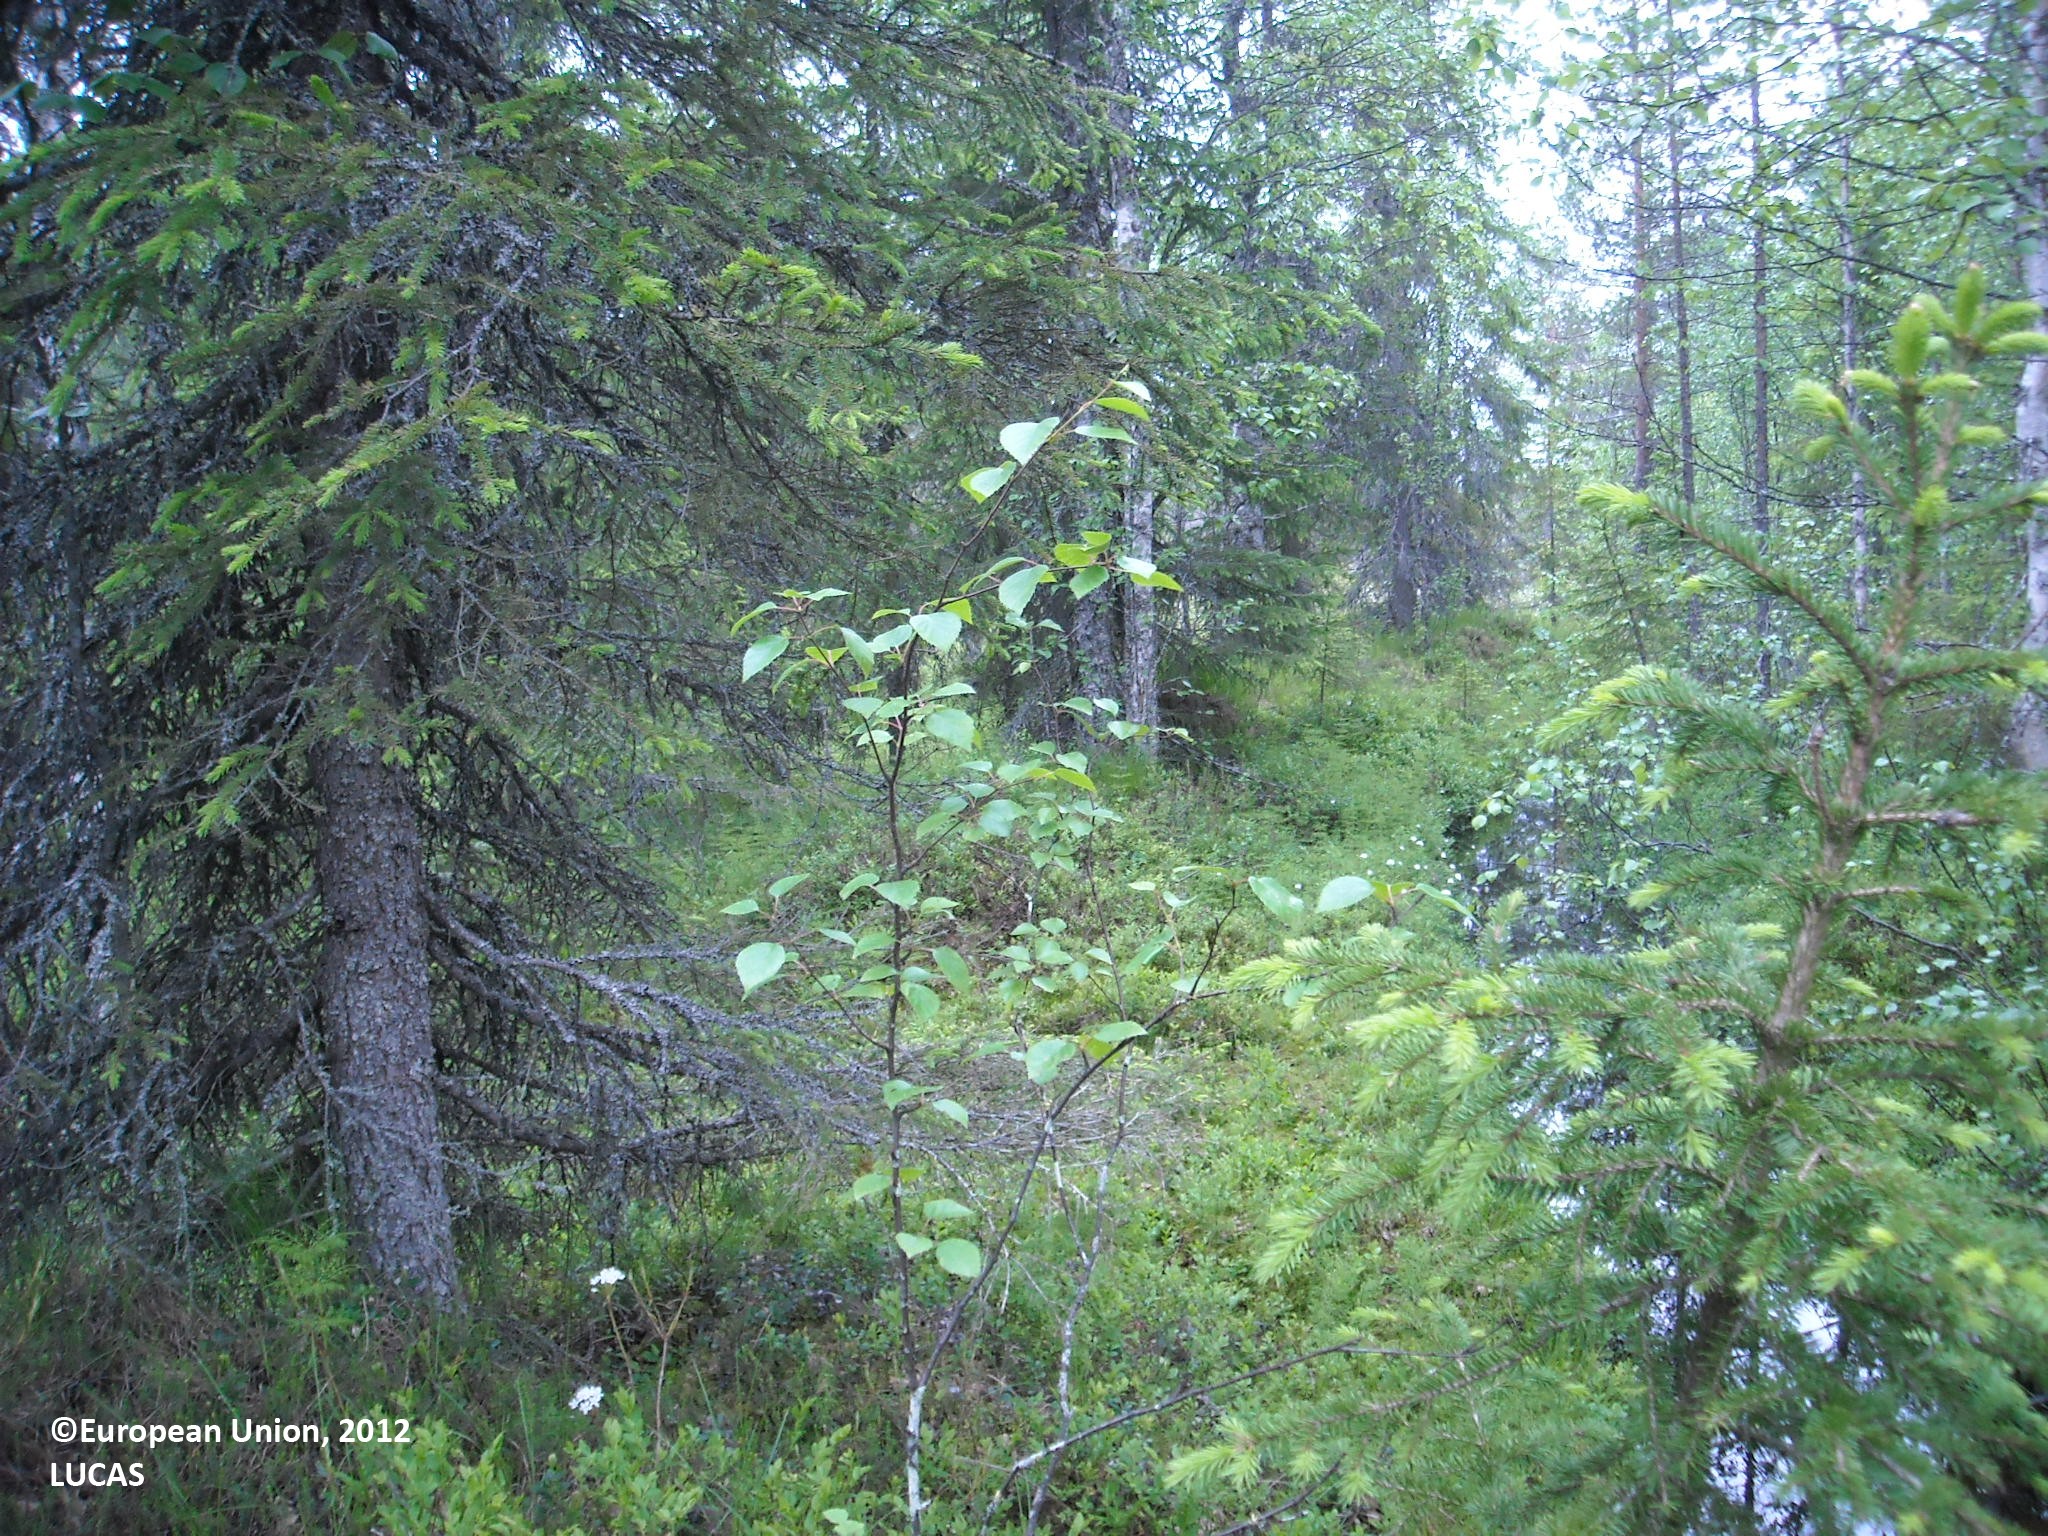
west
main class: Woodland
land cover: Other mixed woodland
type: boreal forest
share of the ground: > 75 %
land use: Forestry
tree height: > 5 m
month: June
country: FI
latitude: 64.9236
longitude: 27.9788
